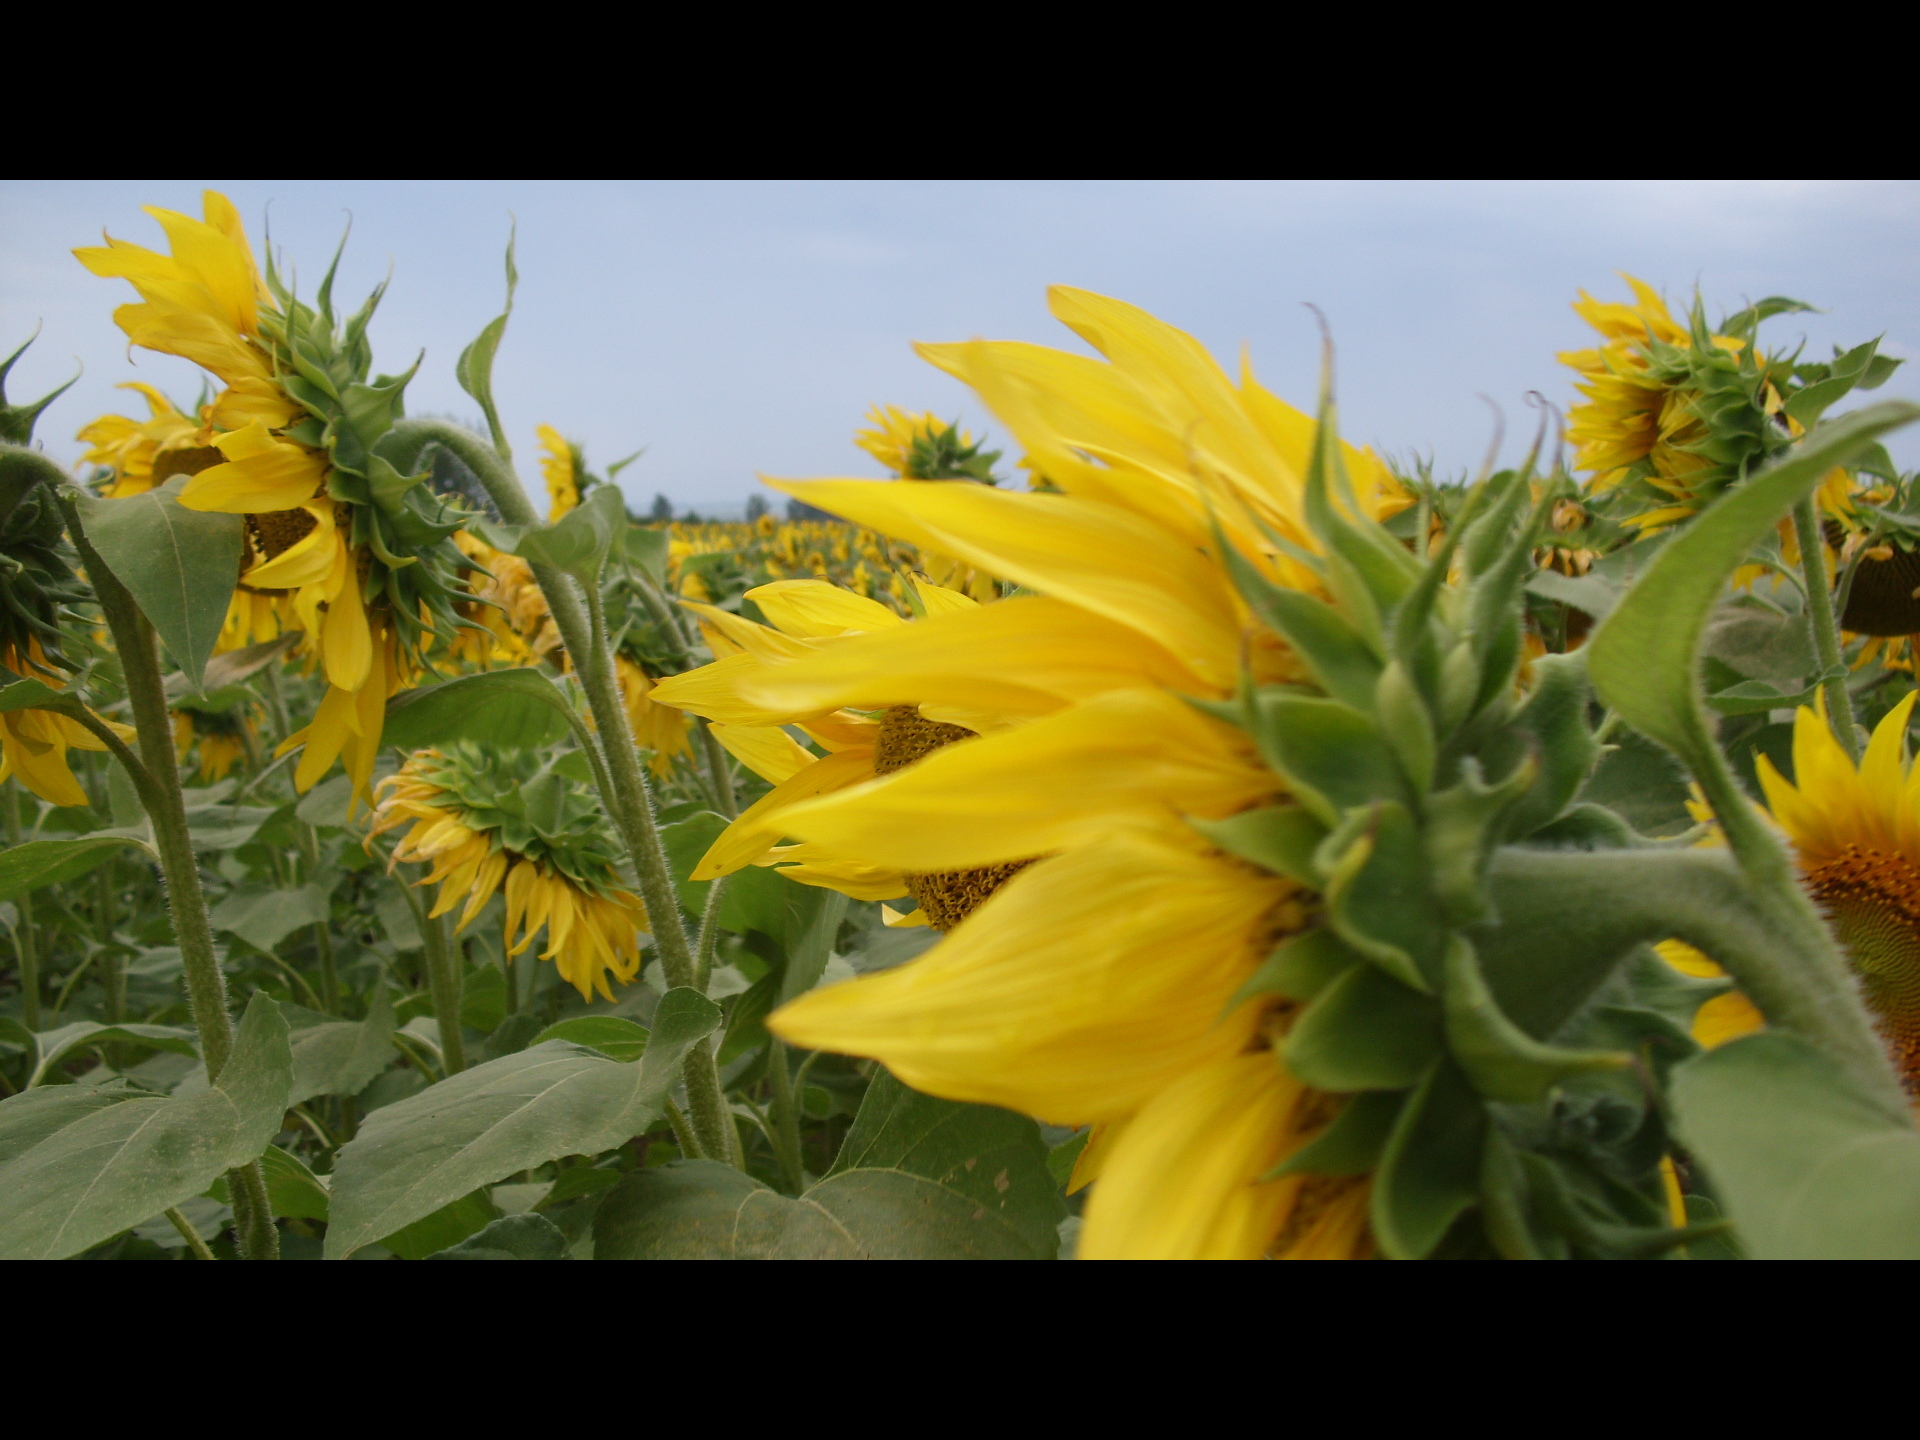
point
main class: Cropland
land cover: Sunflower
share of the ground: > 75 %
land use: Agriculture (excluding fallow land and kitchen gardens)
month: July
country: BG
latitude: 43.9333
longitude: 22.8317
